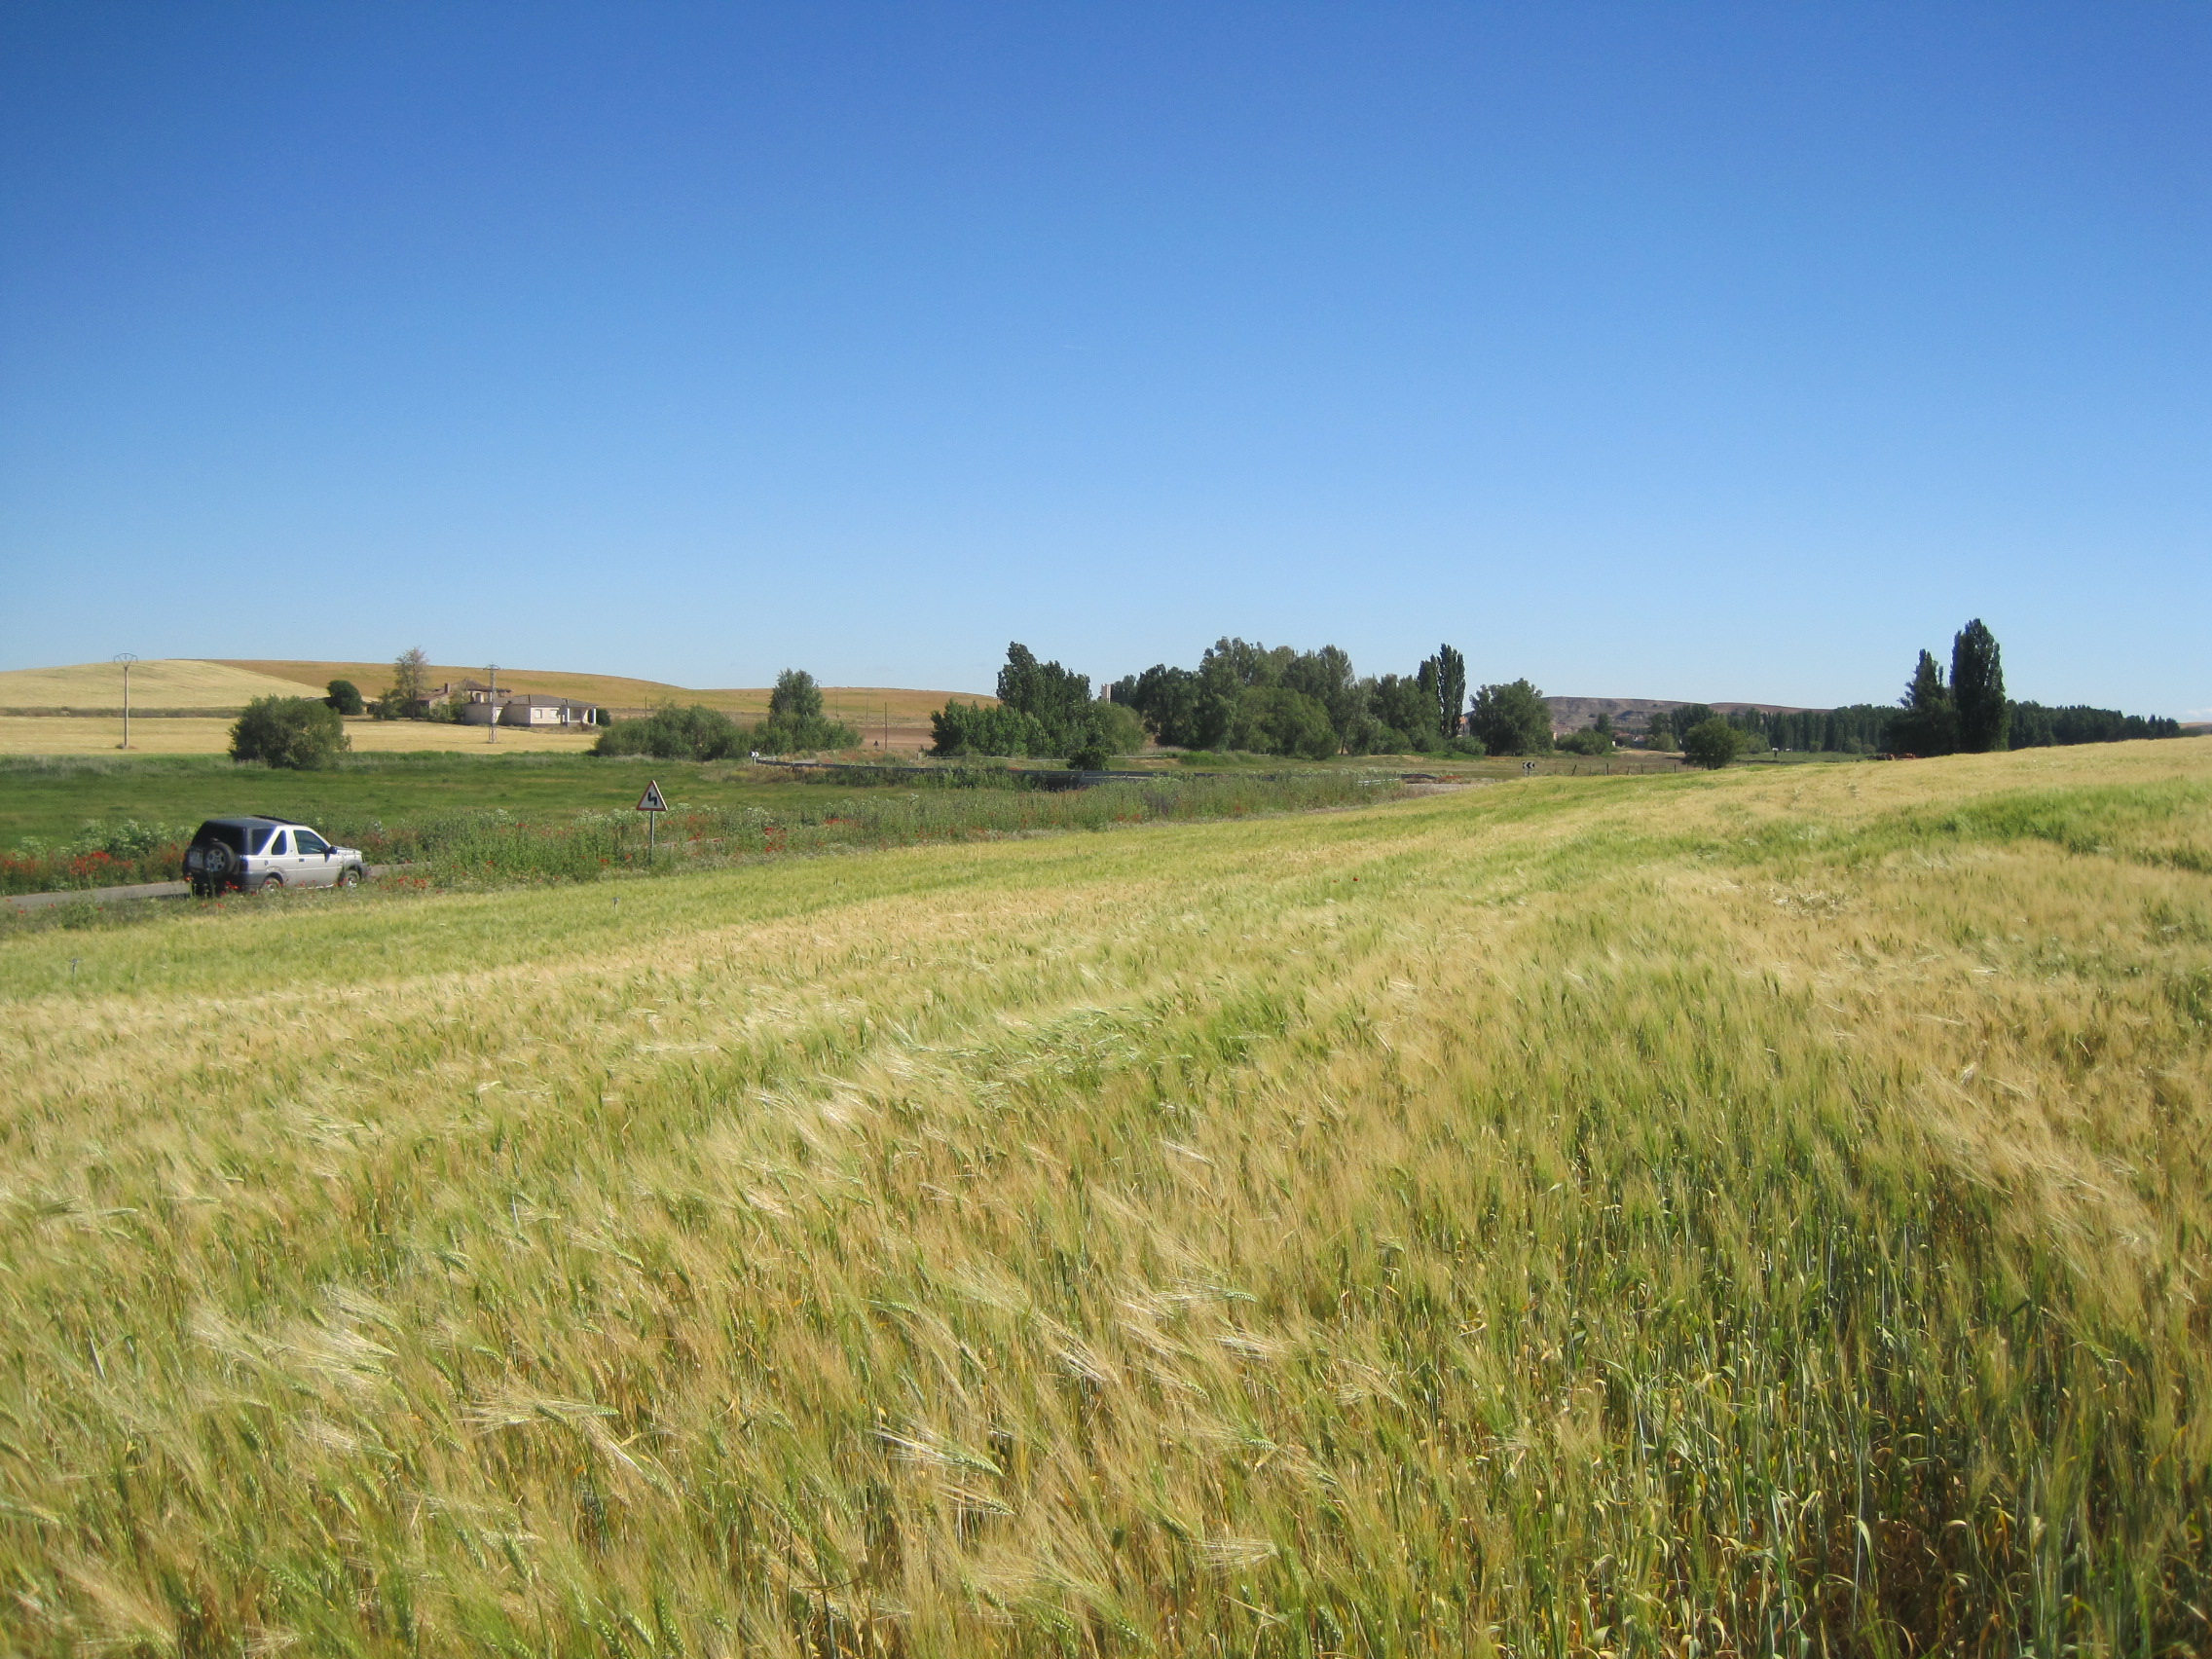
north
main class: Cropland
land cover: Common wheat
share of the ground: > 75 %
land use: Agriculture (excluding fallow land and kitchen gardens)
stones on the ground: < 10 %
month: May
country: ES
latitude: 41.1512
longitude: -5.3134
